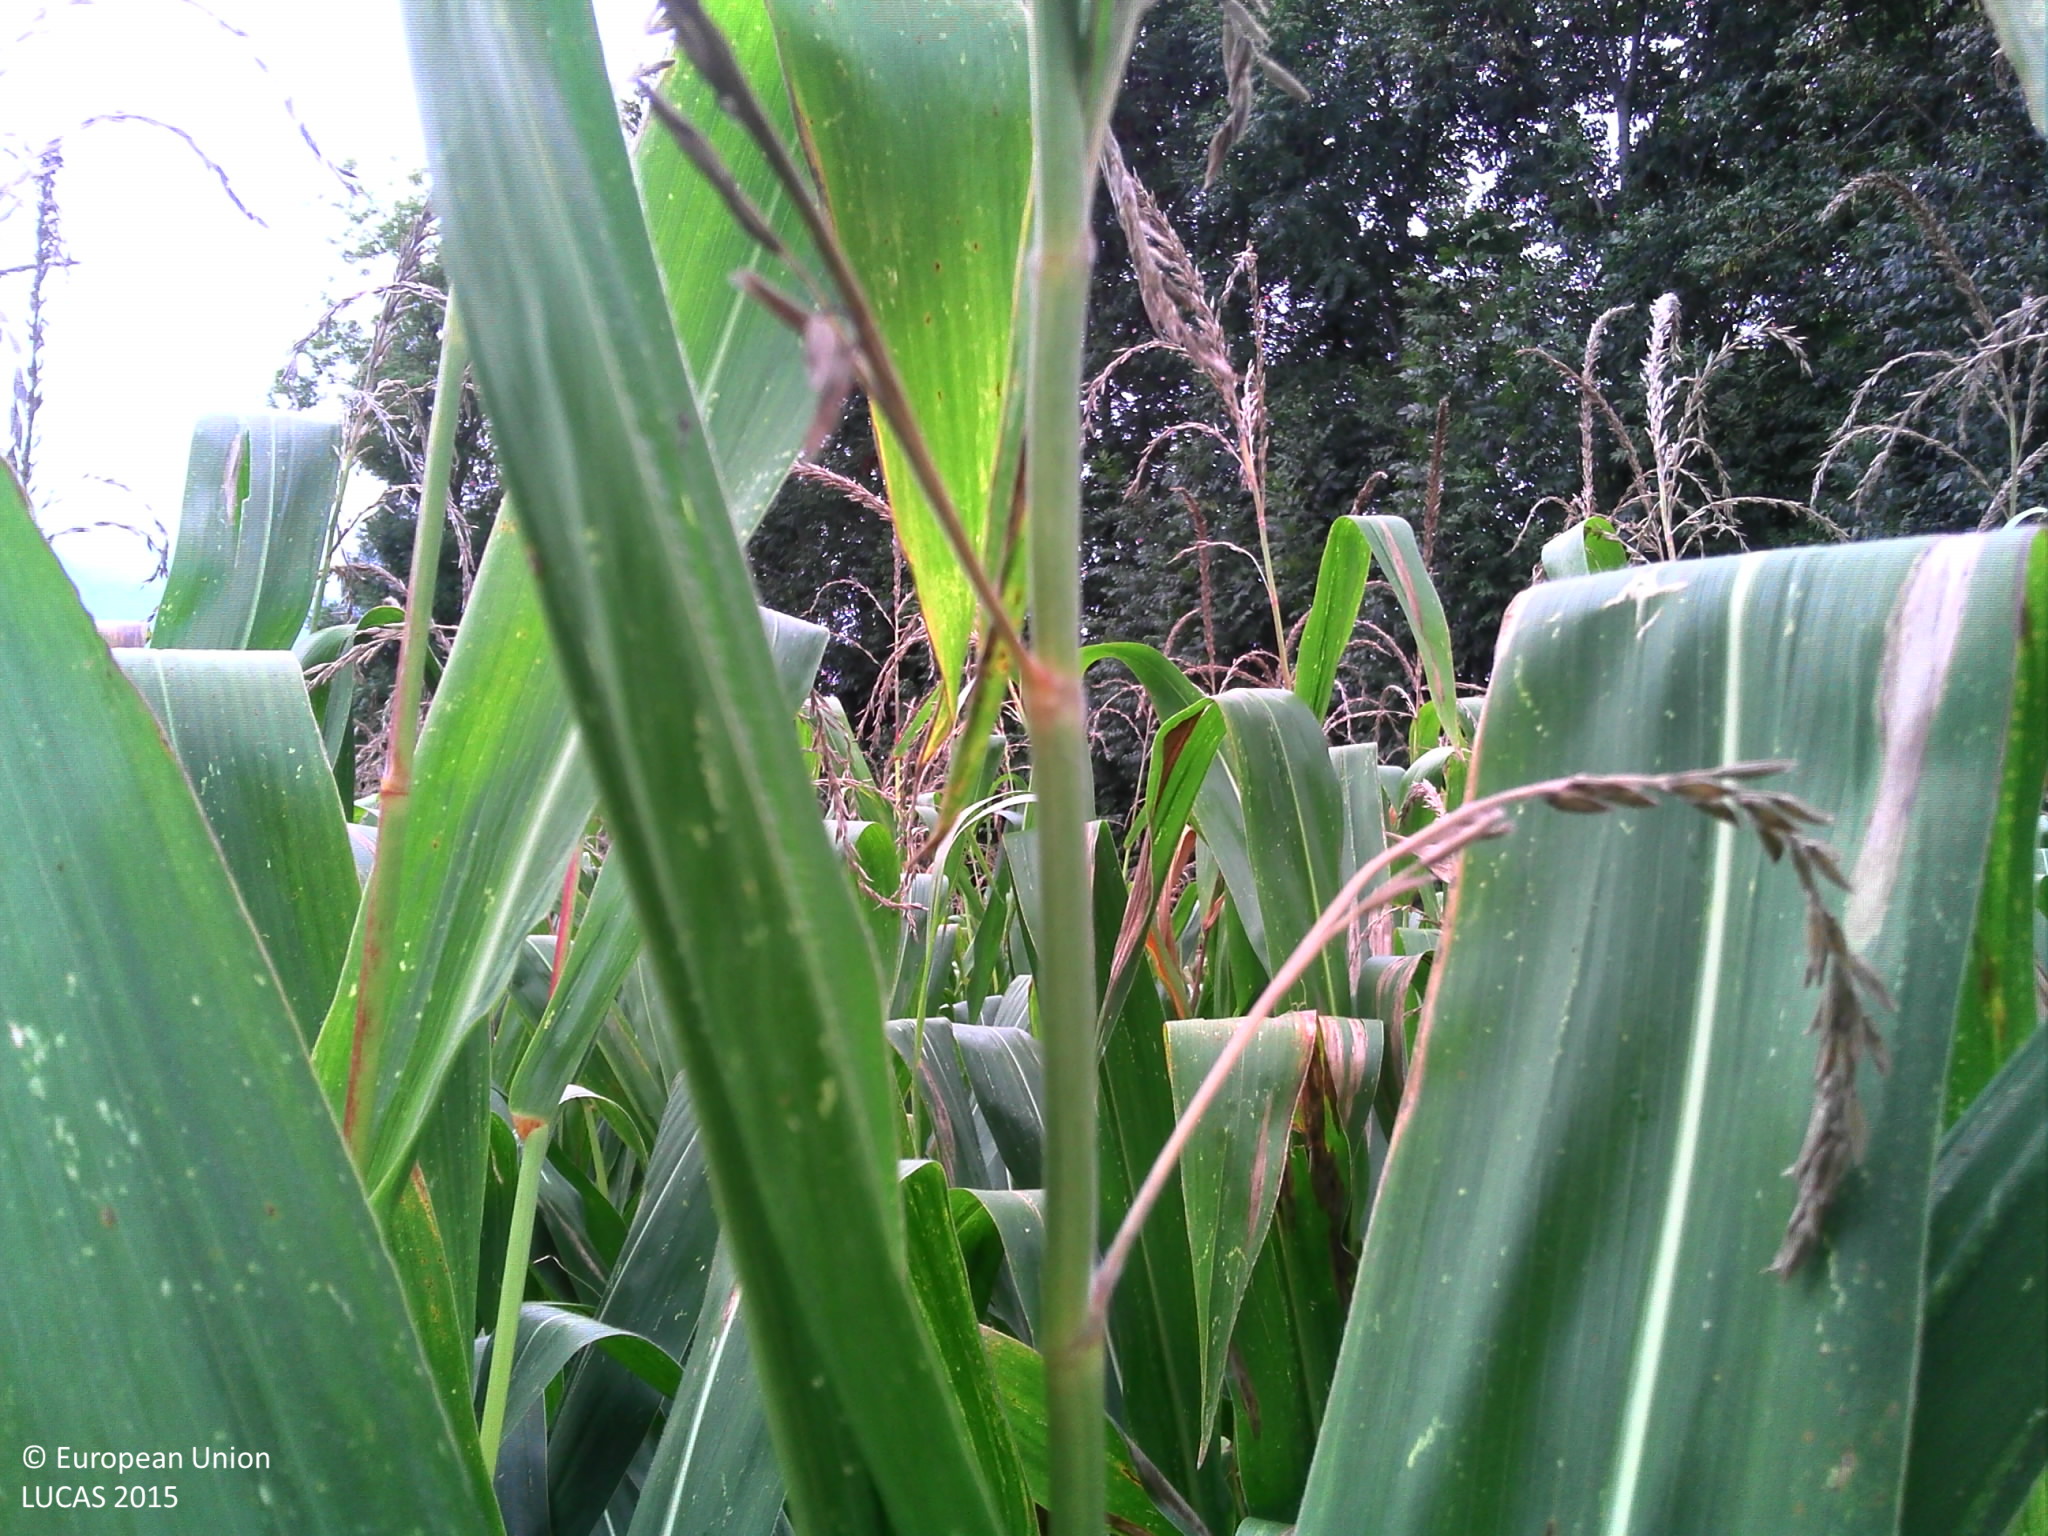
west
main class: Cropland
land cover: Maize
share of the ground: > 75 %
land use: Agriculture (excluding fallow land and kitchen gardens)
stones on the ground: 10 - 25 %
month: September
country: FR
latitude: 43.2885
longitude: -0.1481
